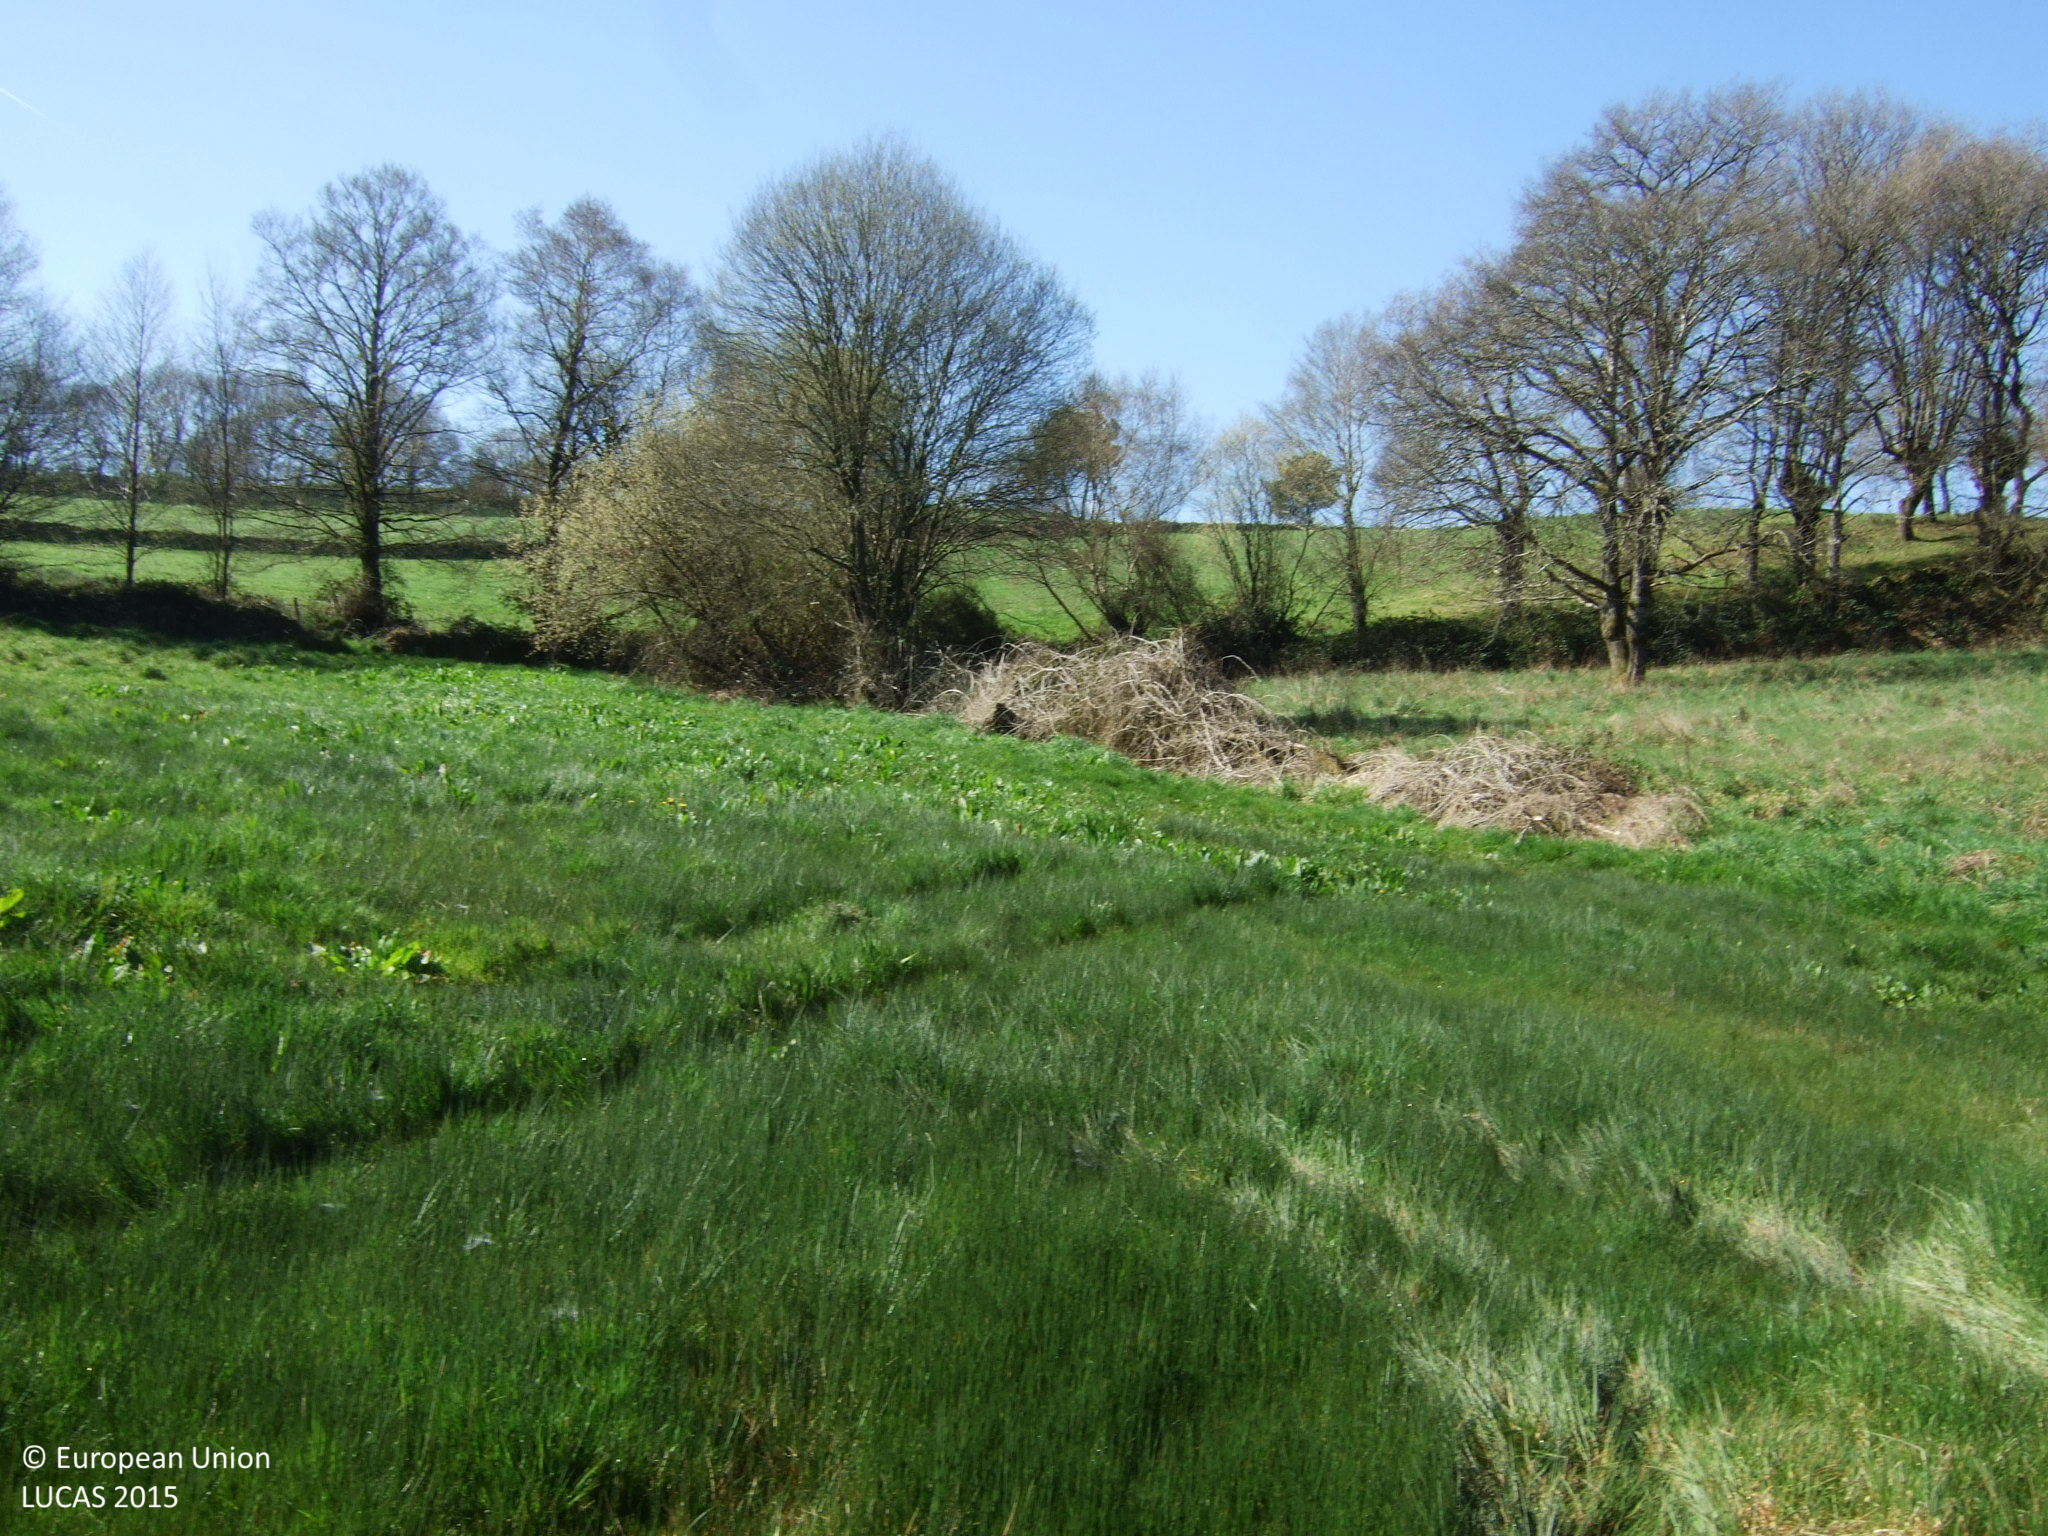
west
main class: Grassland
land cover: Grassland without tree/shrub cover
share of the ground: > 75 %
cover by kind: herbaceous plants 100 %
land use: Agriculture (excluding fallow land and kitchen gardens)
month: April
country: ES
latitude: 42.6965
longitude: -7.8422
